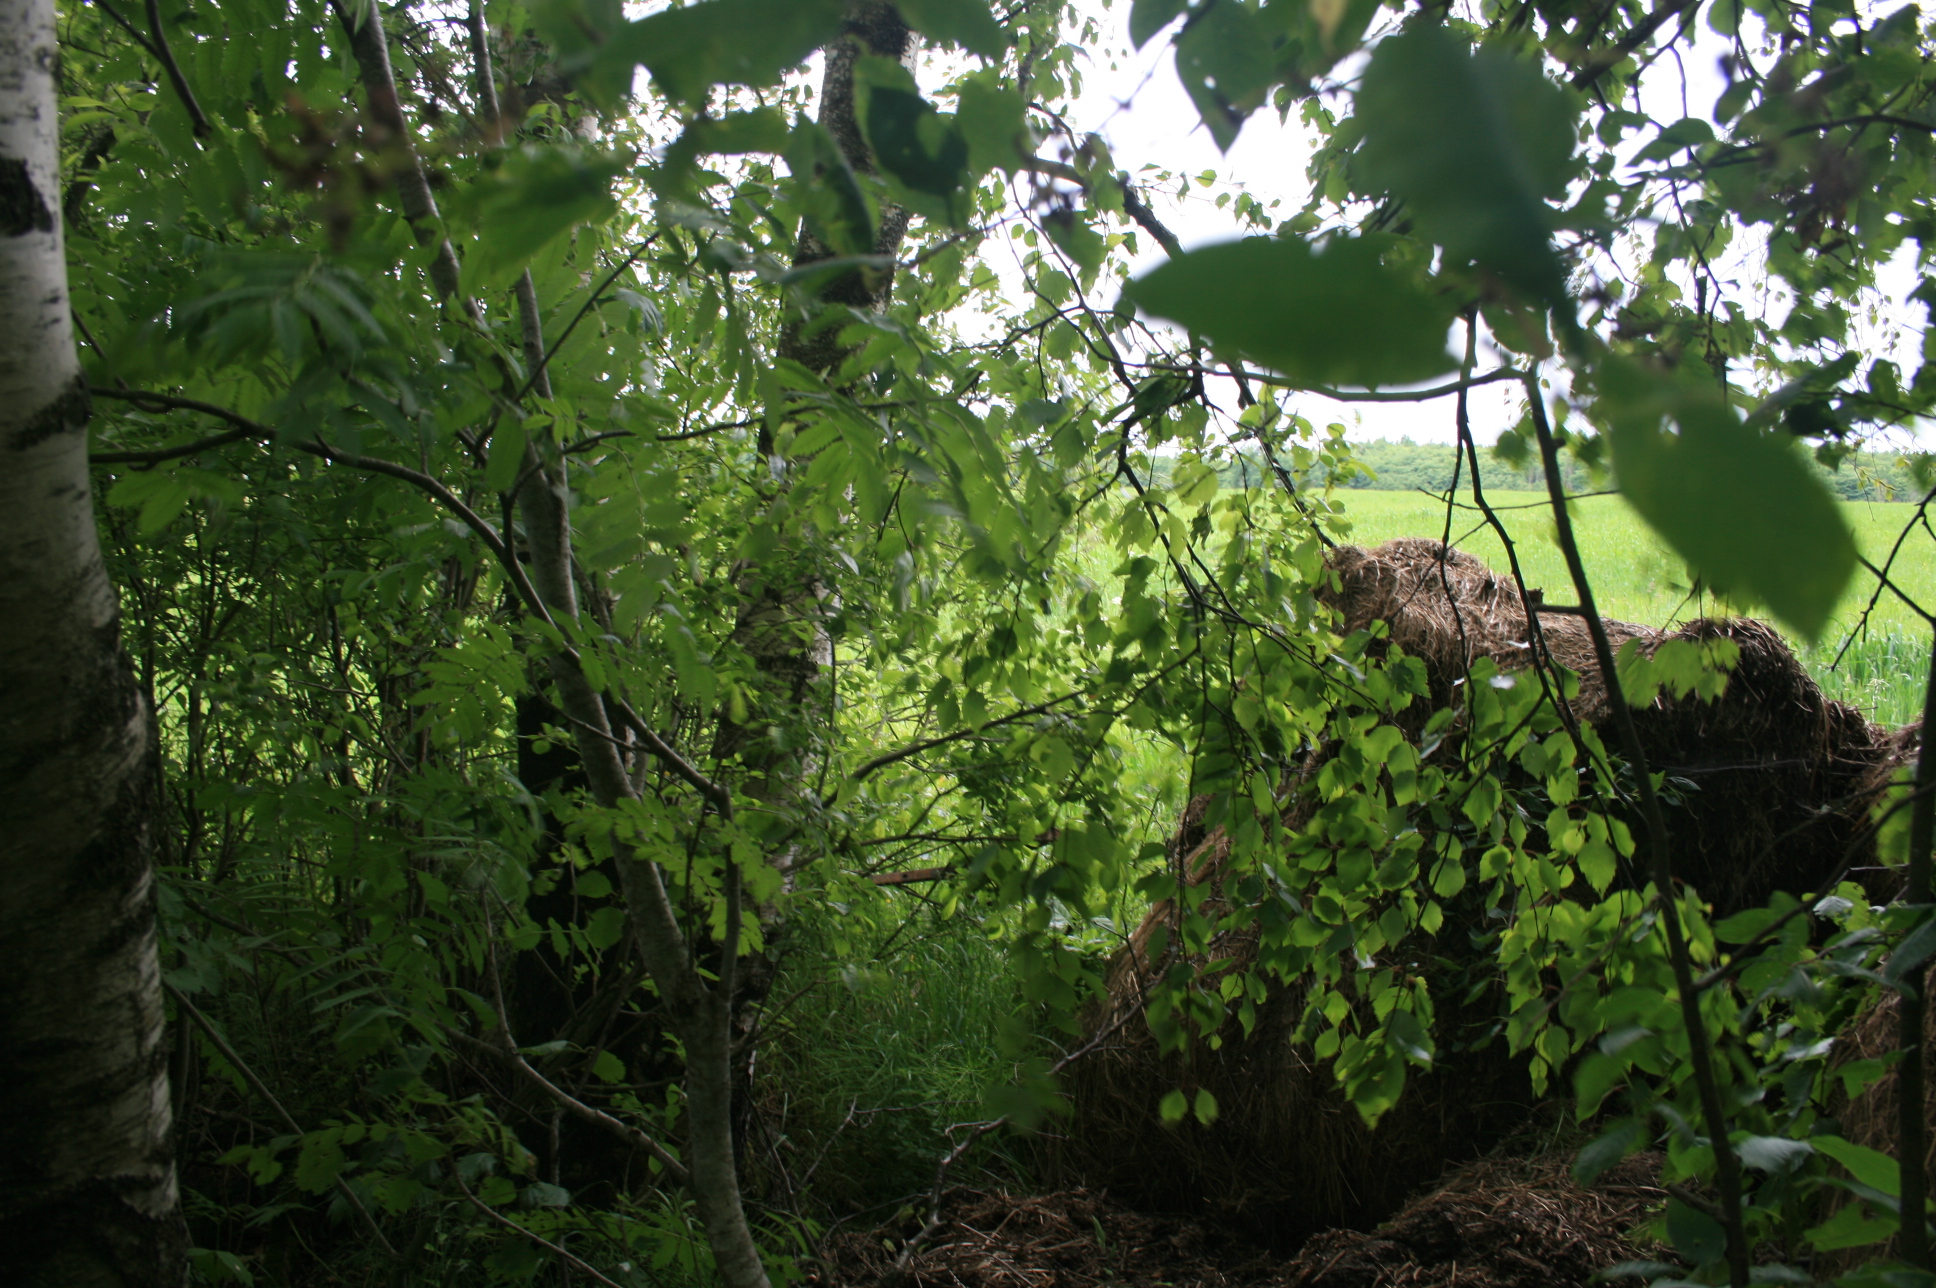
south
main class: Woodland
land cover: Broadleaved woodland
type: non-riverine alder, birch or aspen forest
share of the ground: > 75 %
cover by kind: broadleaved forest trees 80 %, shrubs 10 %, herbaceous plants 10 %
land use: Forestry
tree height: > 5 m
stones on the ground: < 10 %
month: June
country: LT
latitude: 55.6409
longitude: 22.3713
